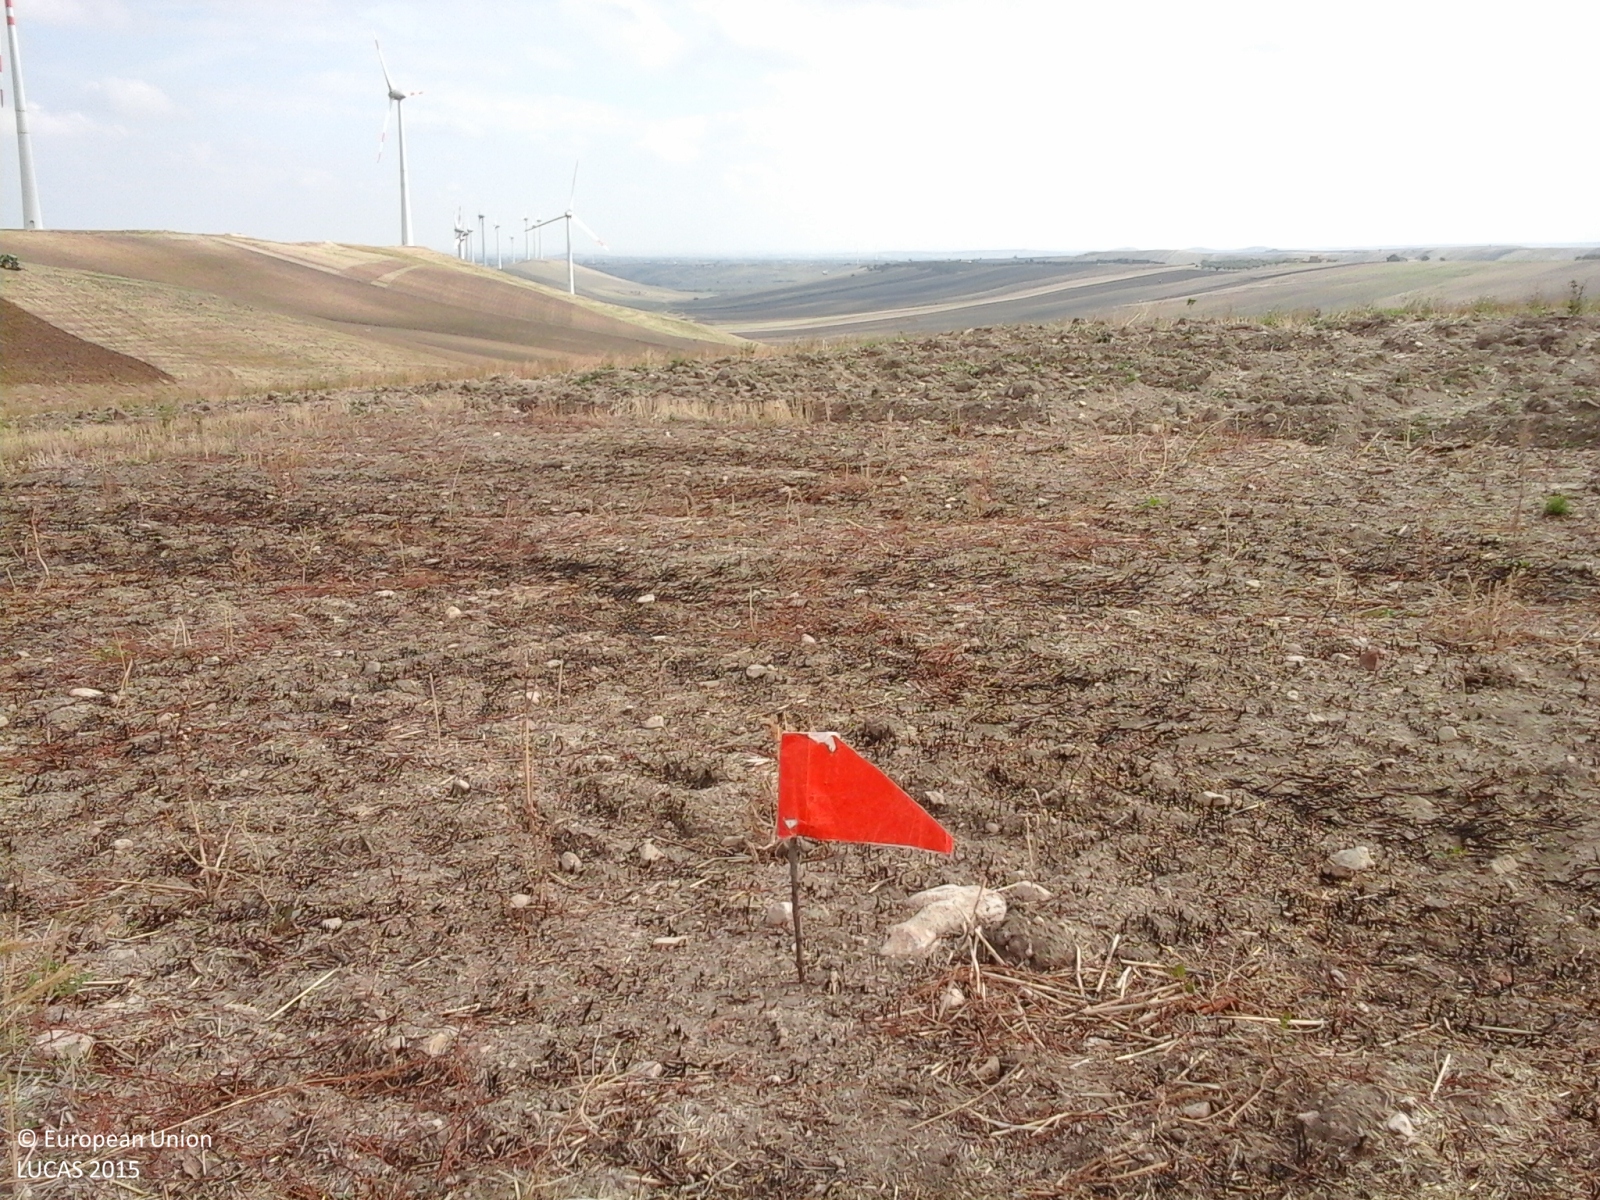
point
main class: Cropland
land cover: Durum wheat
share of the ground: > 75 %
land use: Agriculture (excluding fallow land and kitchen gardens)
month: October
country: IT
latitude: 41.4710
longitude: 15.1912
